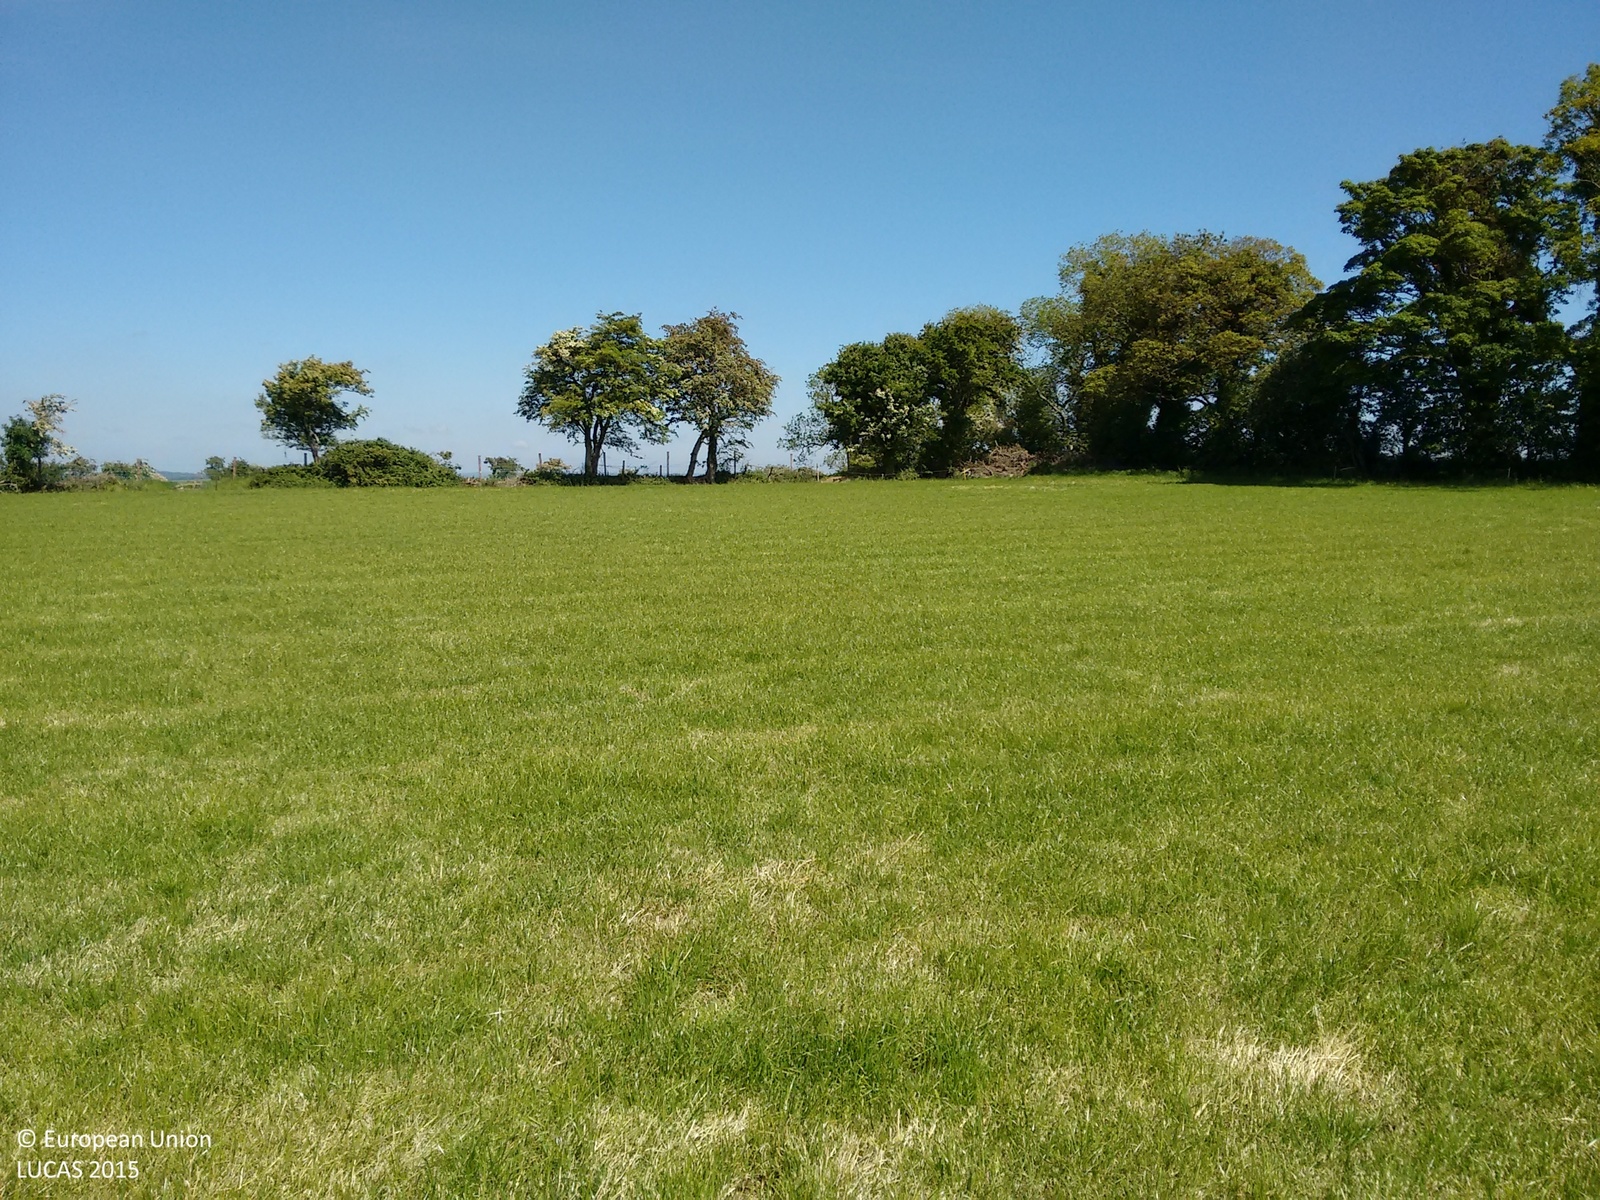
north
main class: Grassland
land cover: Grassland without tree/shrub cover
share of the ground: > 75 %
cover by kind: herbaceous plants 90 %, unconsolidated bare surface 10 %
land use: Agriculture (excluding fallow land and kitchen gardens)
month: June
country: IE
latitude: 53.5932
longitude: -6.5510
